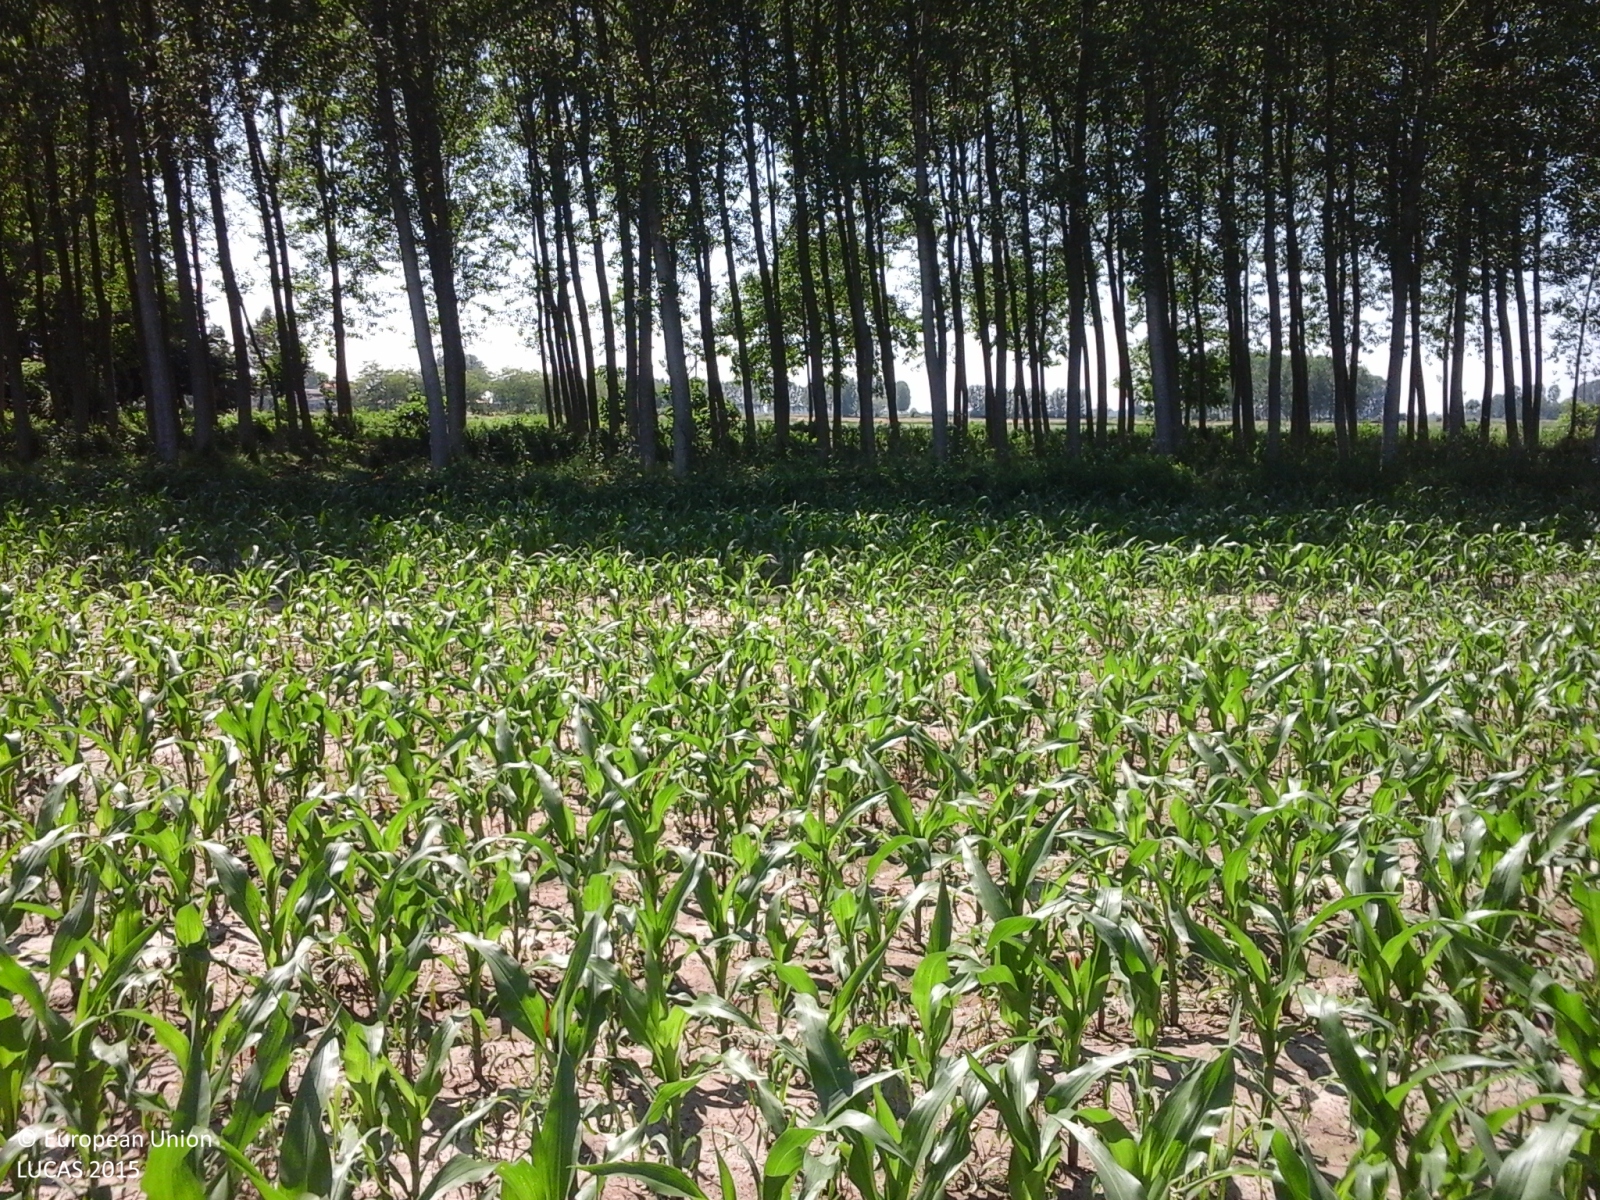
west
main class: Cropland
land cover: Maize
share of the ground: 50 - 75 %
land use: Agriculture (excluding fallow land and kitchen gardens)
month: May
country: IT
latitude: 45.2983
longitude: 8.7143
